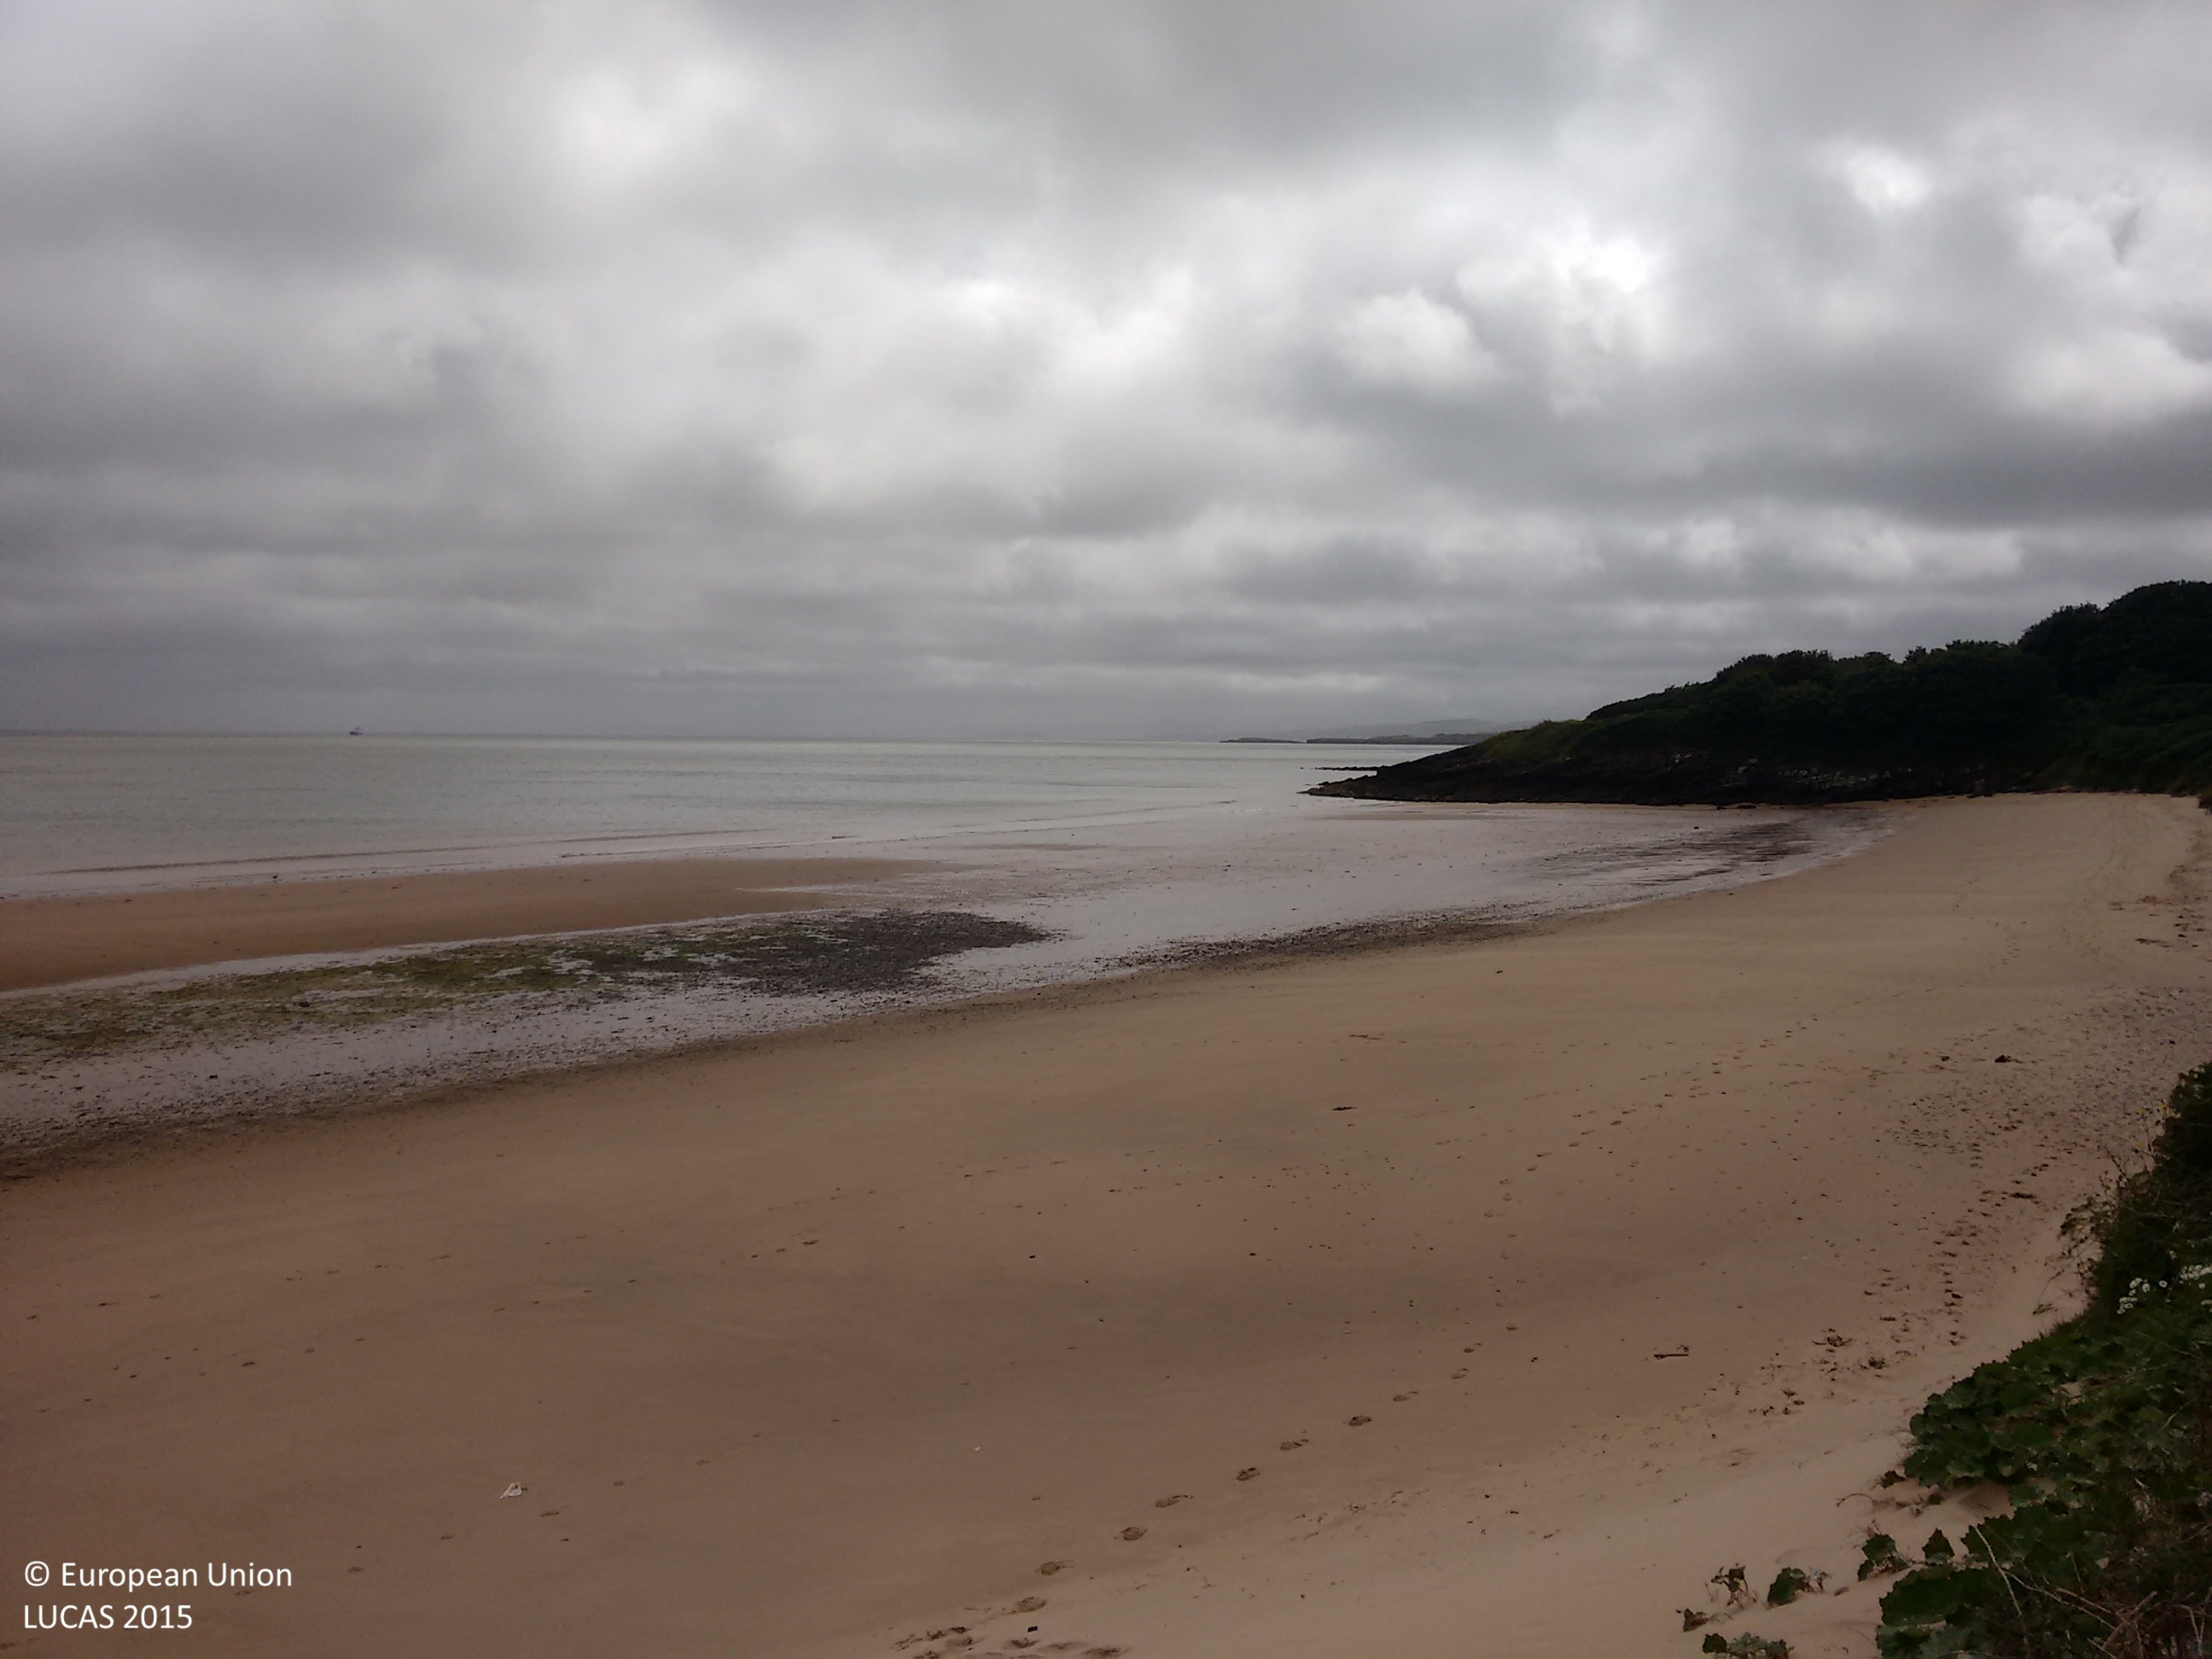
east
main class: Shrubland
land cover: Shrubland without tree cover
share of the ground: > 75 %
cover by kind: shrubs 100 %
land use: Semi-natural and natural areas not in use
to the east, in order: Shrubland without tree cover; Spontaneously vegetated surfaces; Sand; Intertidal flats
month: August
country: GB
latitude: 53.3728
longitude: -4.2735
